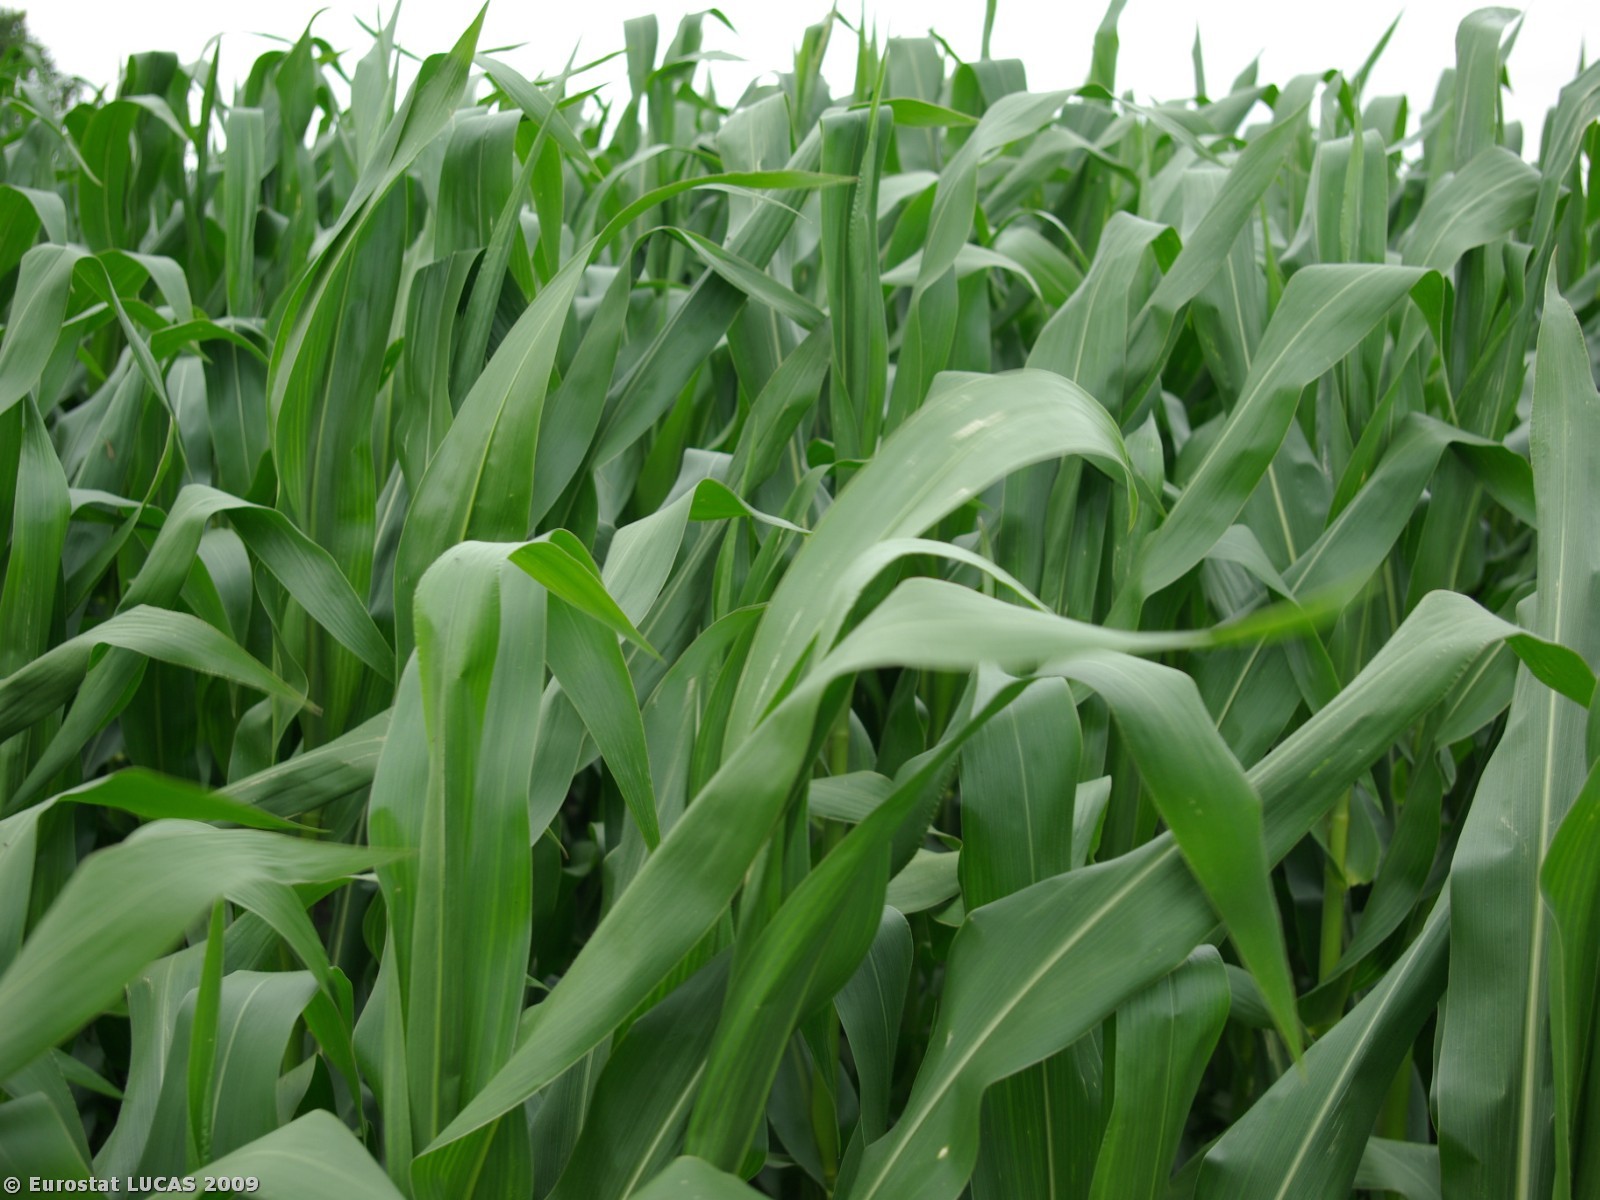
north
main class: Cropland
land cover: Maize
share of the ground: > 75 %
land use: Agriculture (excluding fallow land and kitchen gardens)
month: July
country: DK
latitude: 55.2125
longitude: 8.9165
